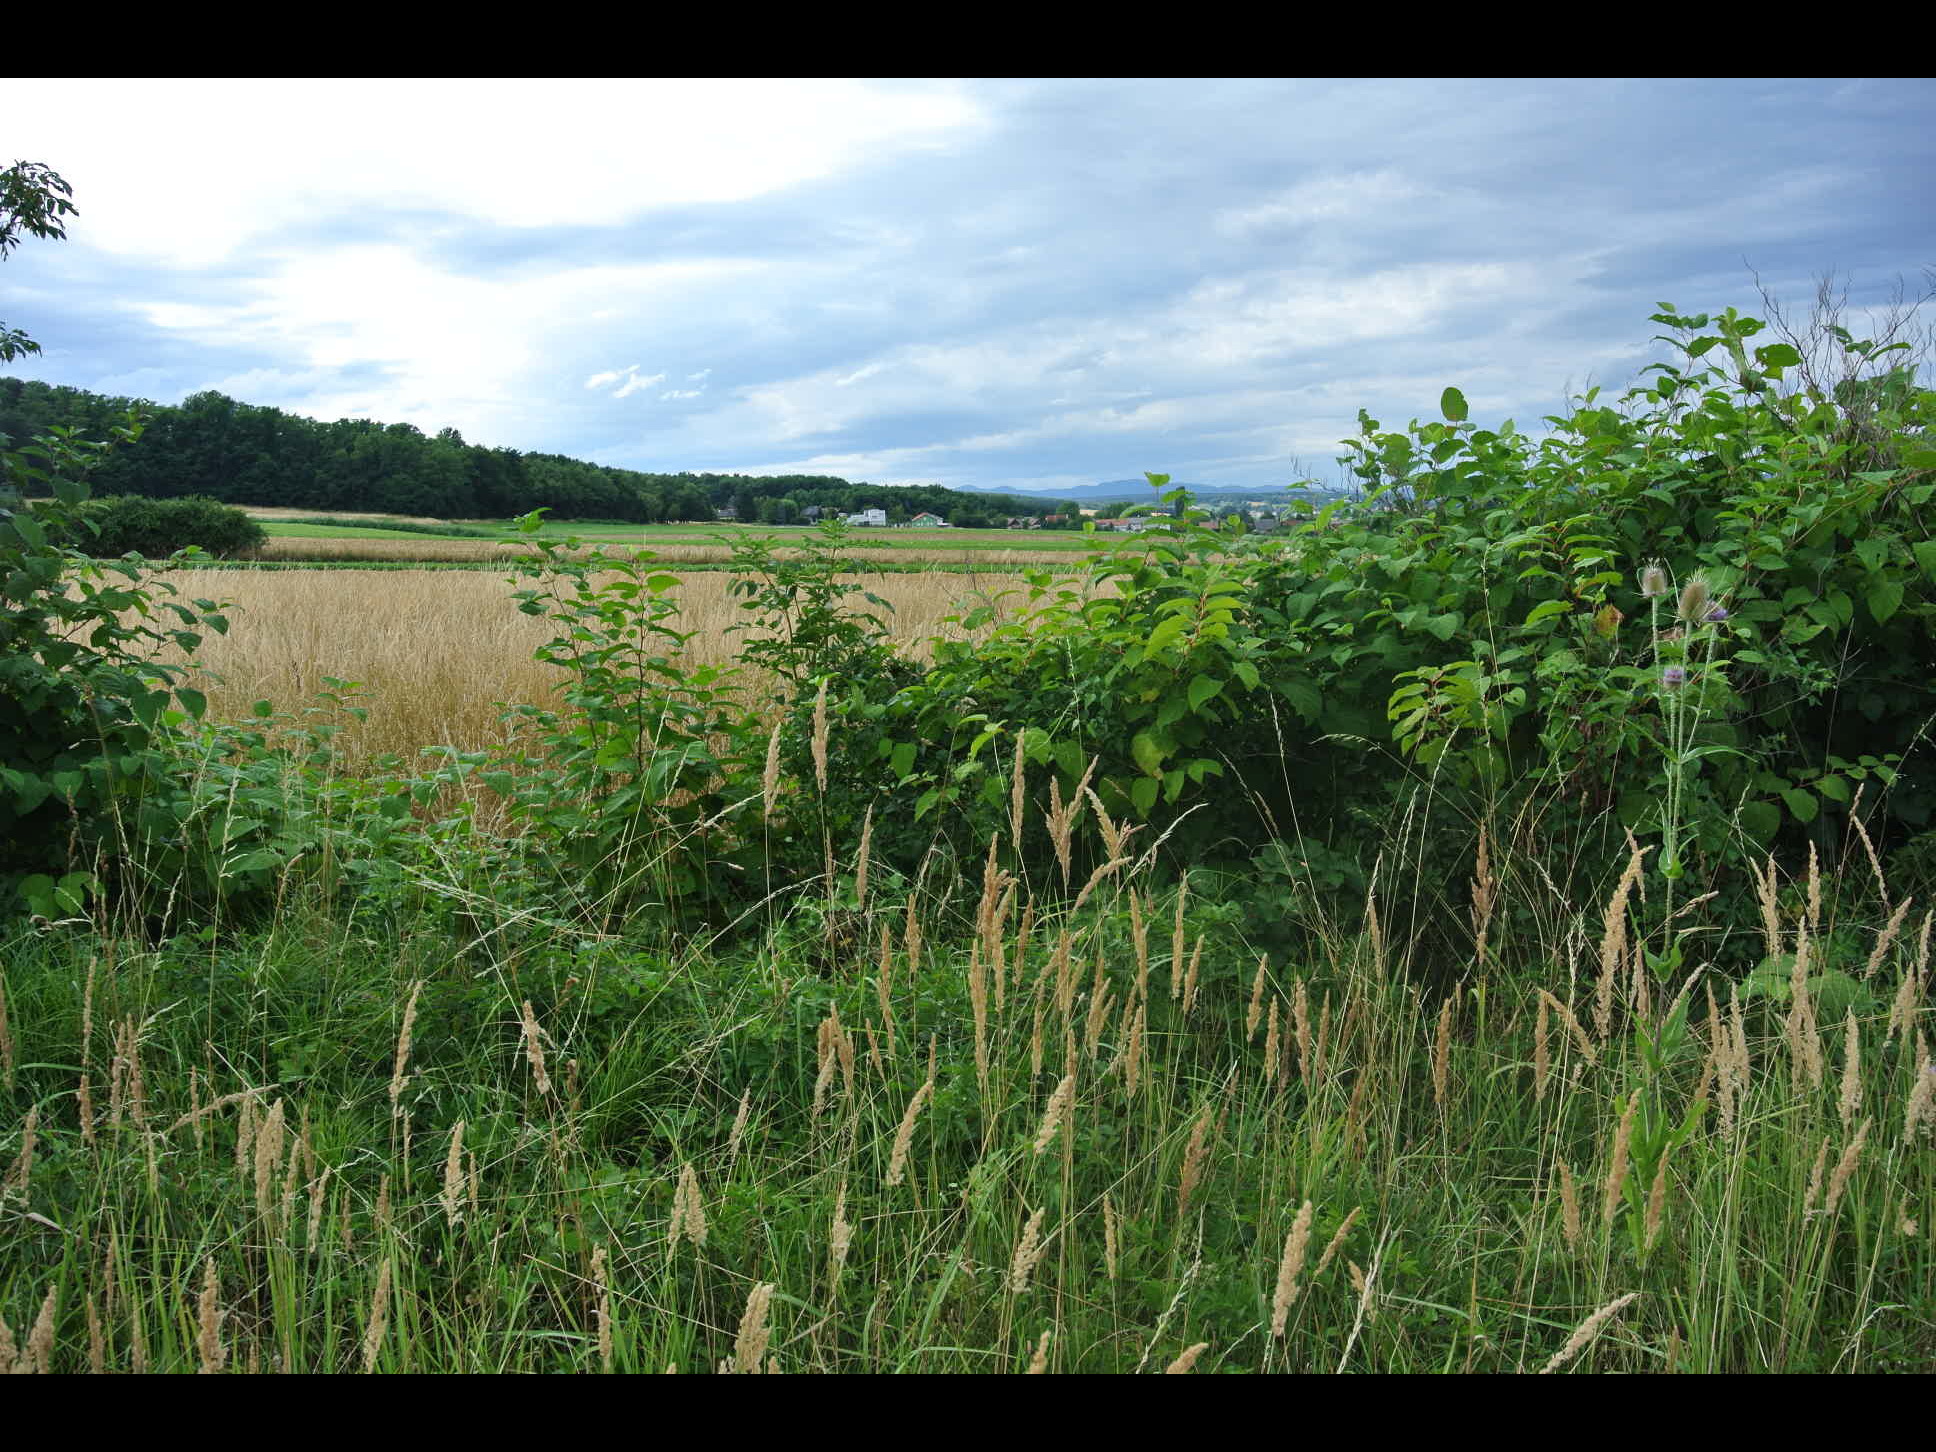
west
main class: Grassland
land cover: Spontaneously vegetated surfaces
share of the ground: > 75 %
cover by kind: herbaceous plants 95 %, unconsolidated bare surface 5 %
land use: Abandoned areas
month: July
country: AT
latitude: 47.4693
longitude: 16.5448
